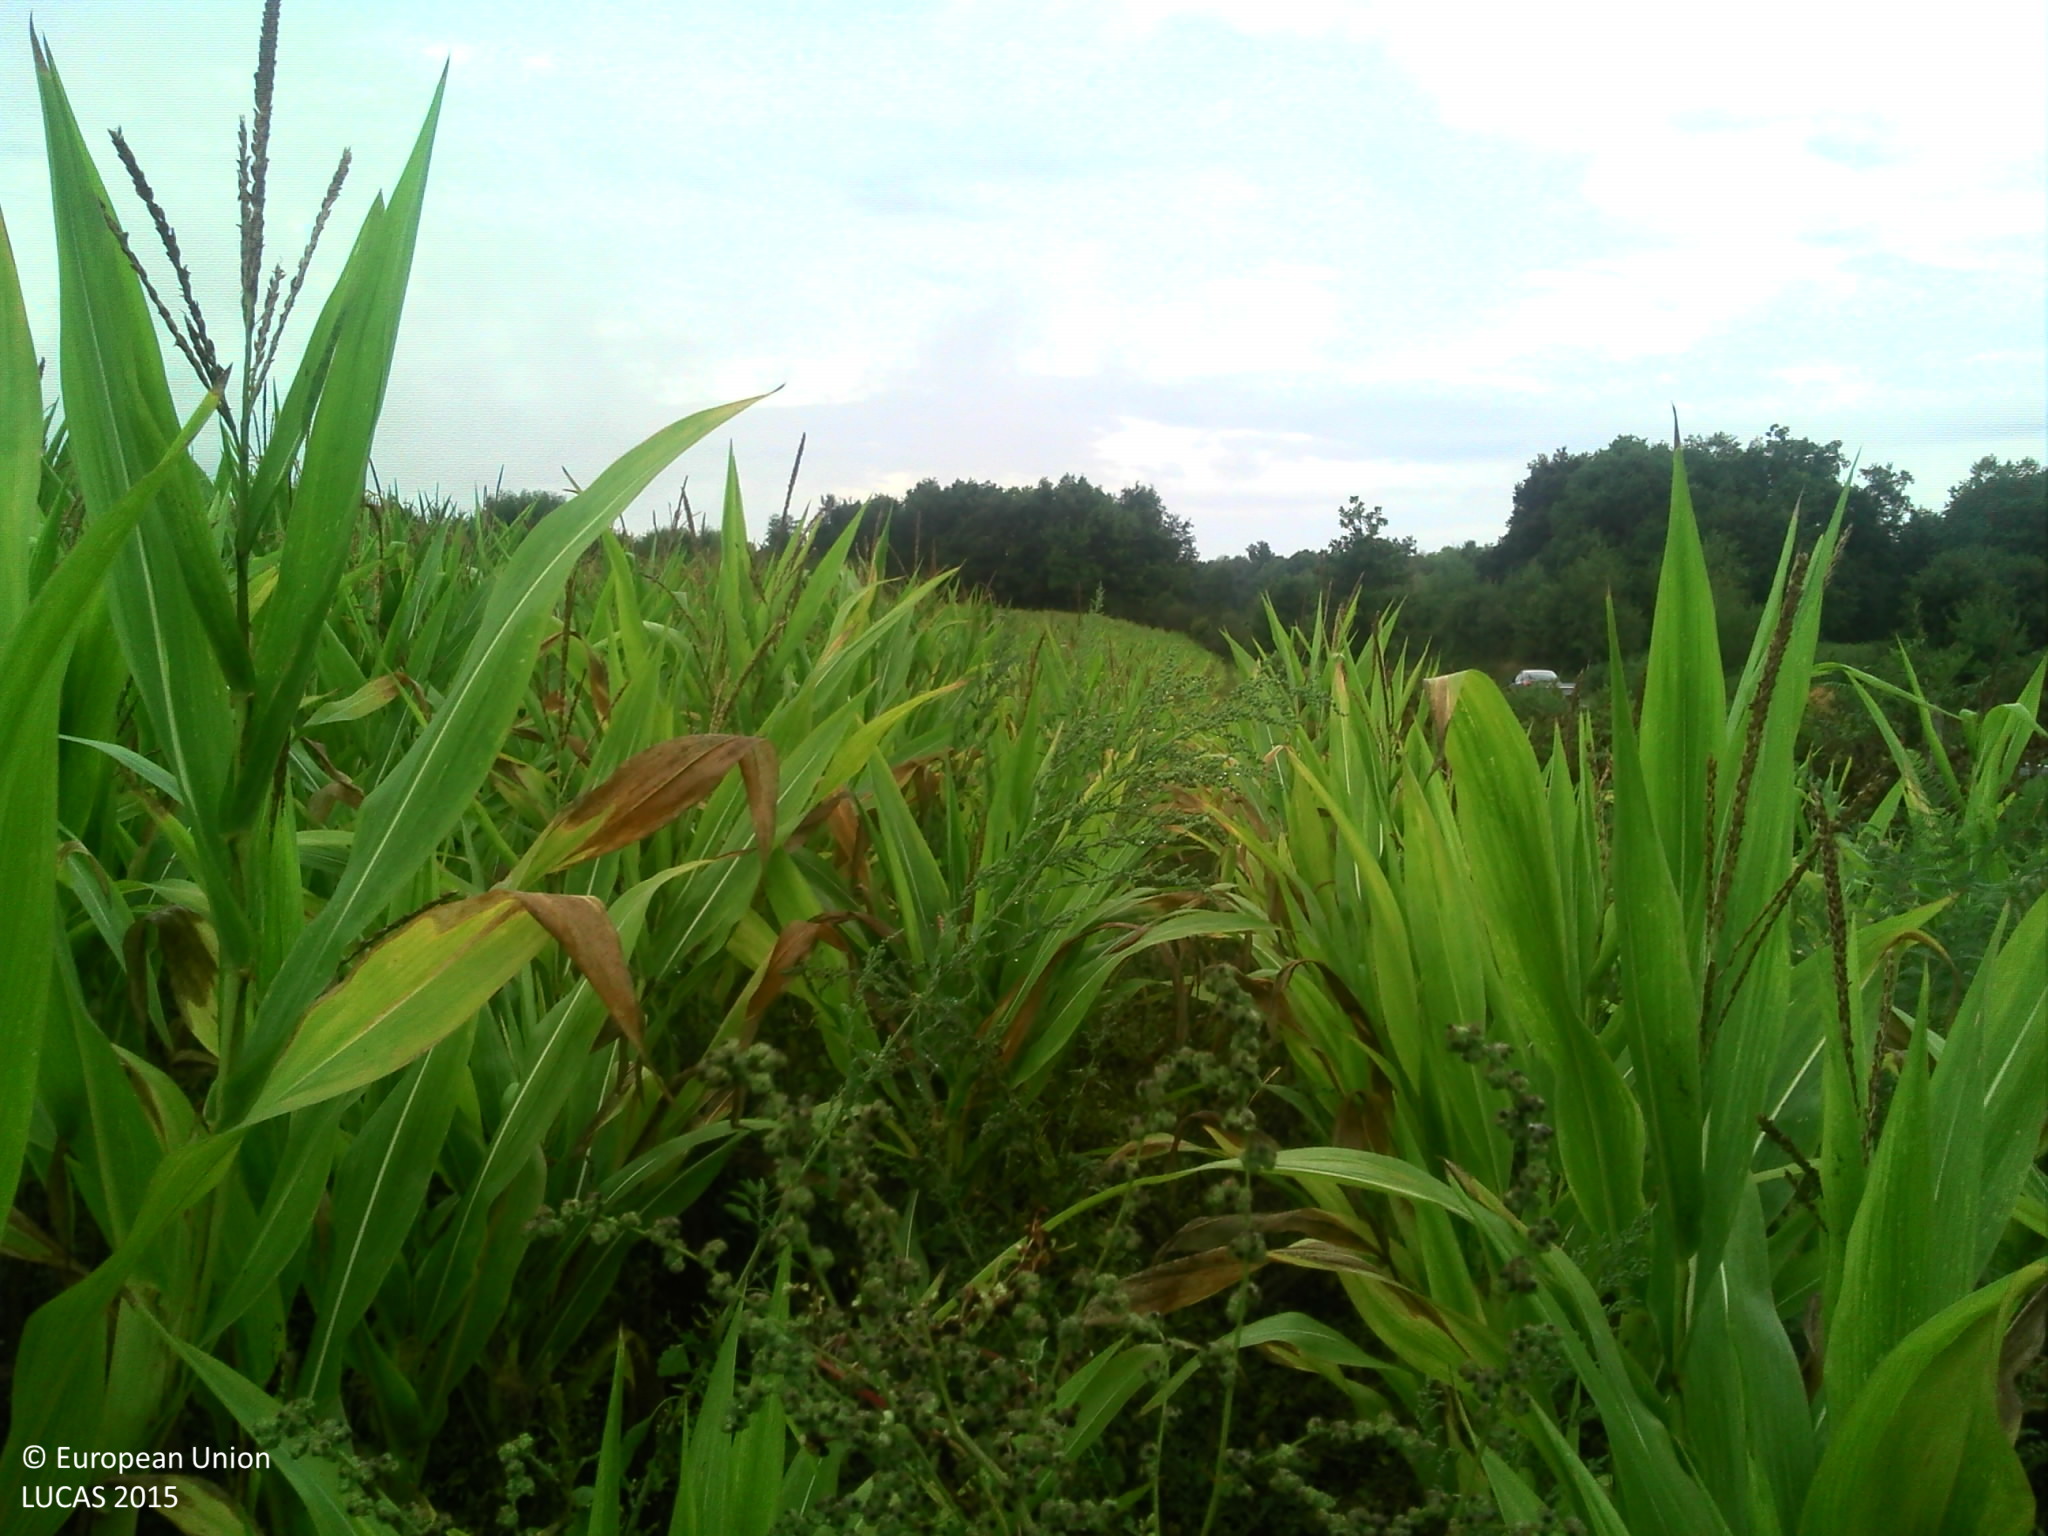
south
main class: Cropland
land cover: Maize
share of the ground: > 75 %
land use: Agriculture (excluding fallow land and kitchen gardens)
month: August
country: FR
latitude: 45.9662
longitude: 0.9420
